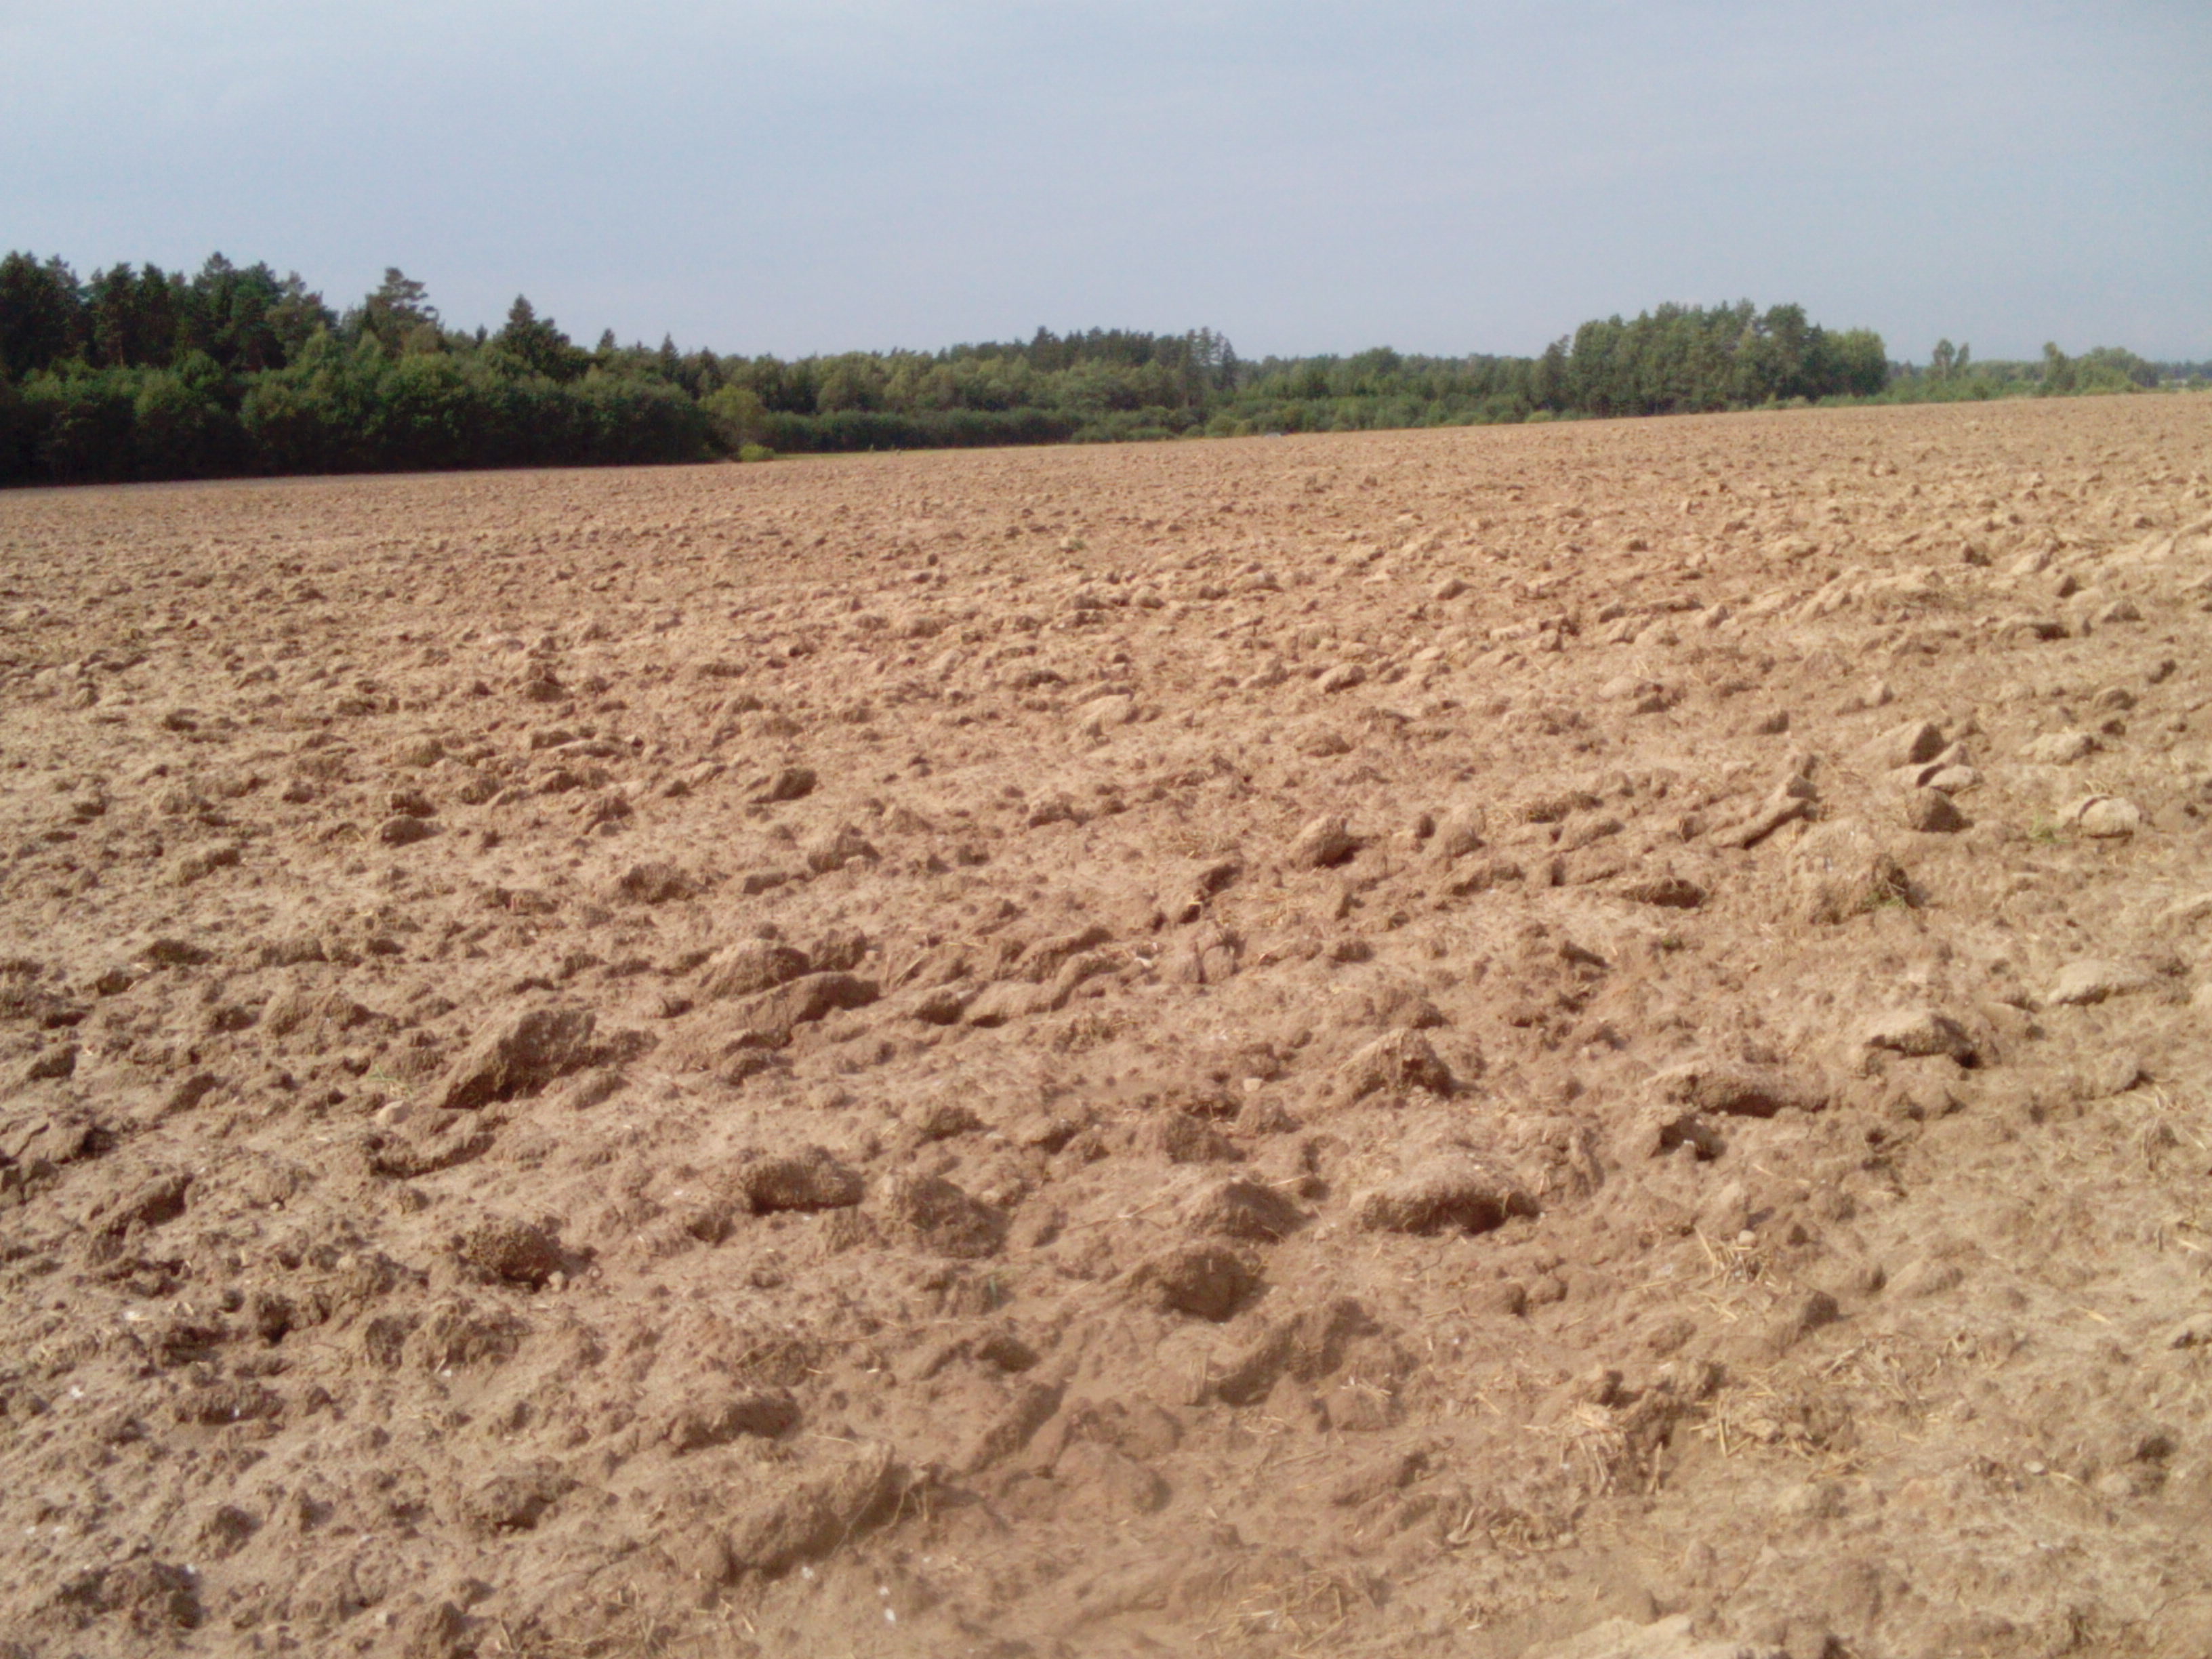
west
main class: Cropland
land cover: Dry pulses
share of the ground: < 10 %
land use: Agriculture (excluding fallow land and kitchen gardens)
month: September
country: LT
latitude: 55.7862
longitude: 22.7417
